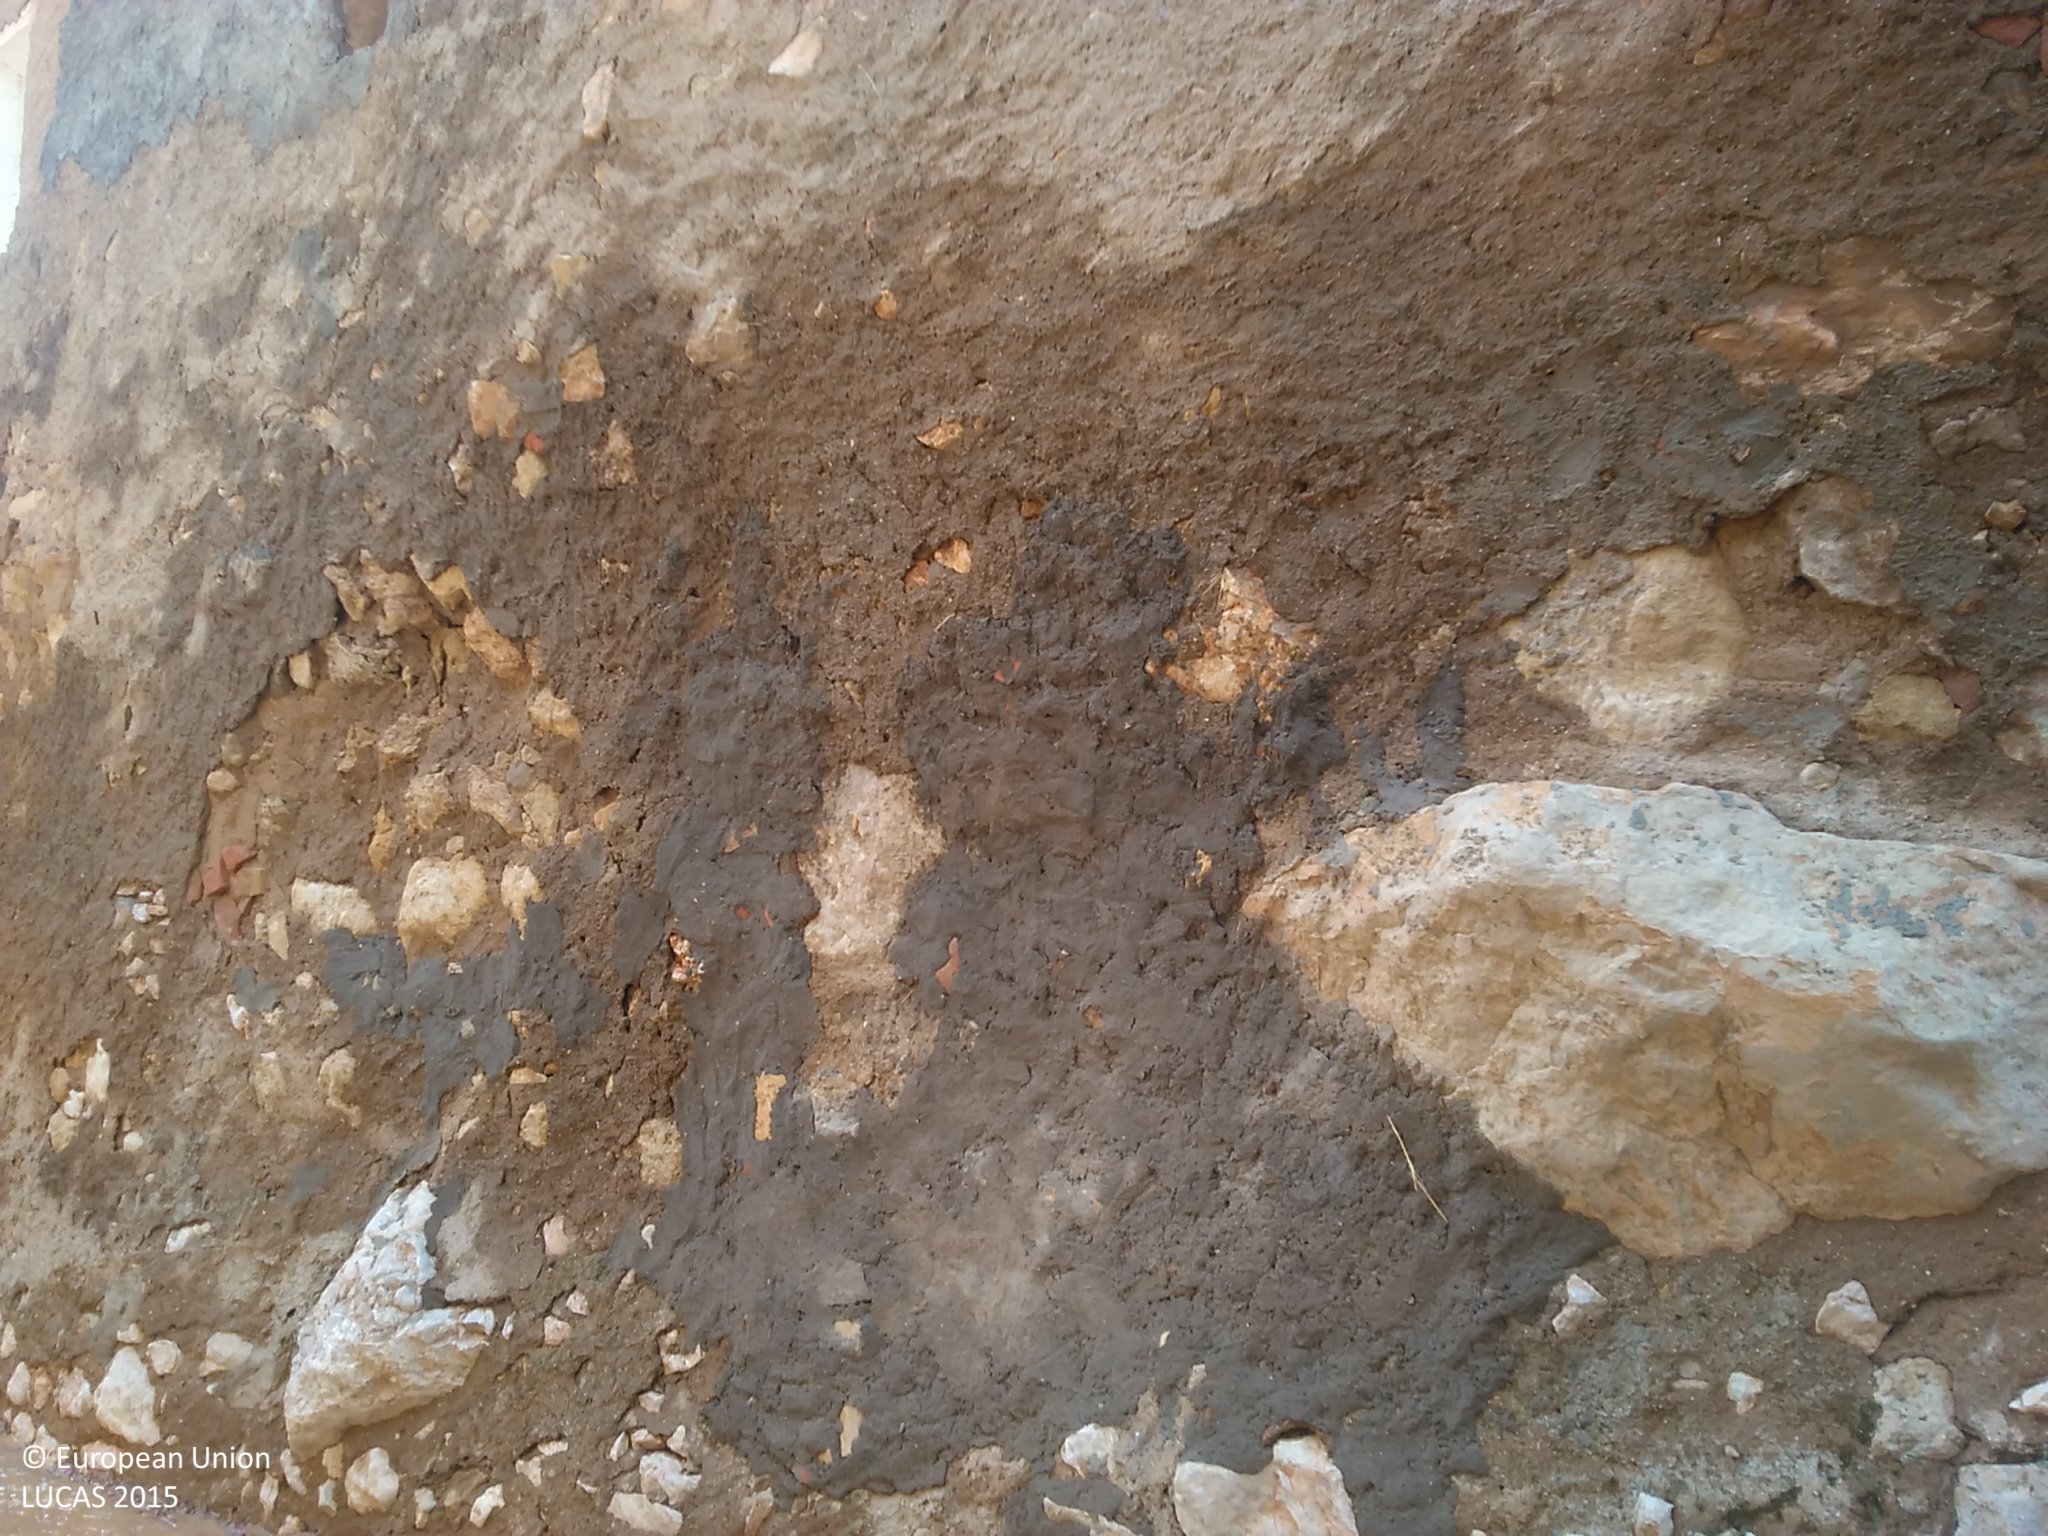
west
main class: Shrubland
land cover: Shrubland without tree cover
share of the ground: 10 - 25 %
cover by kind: unconsolidated bare surface 80 %, shrubs 20 %
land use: Semi-natural and natural areas not in use
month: July
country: ES
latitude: 41.3962
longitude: -1.9532
